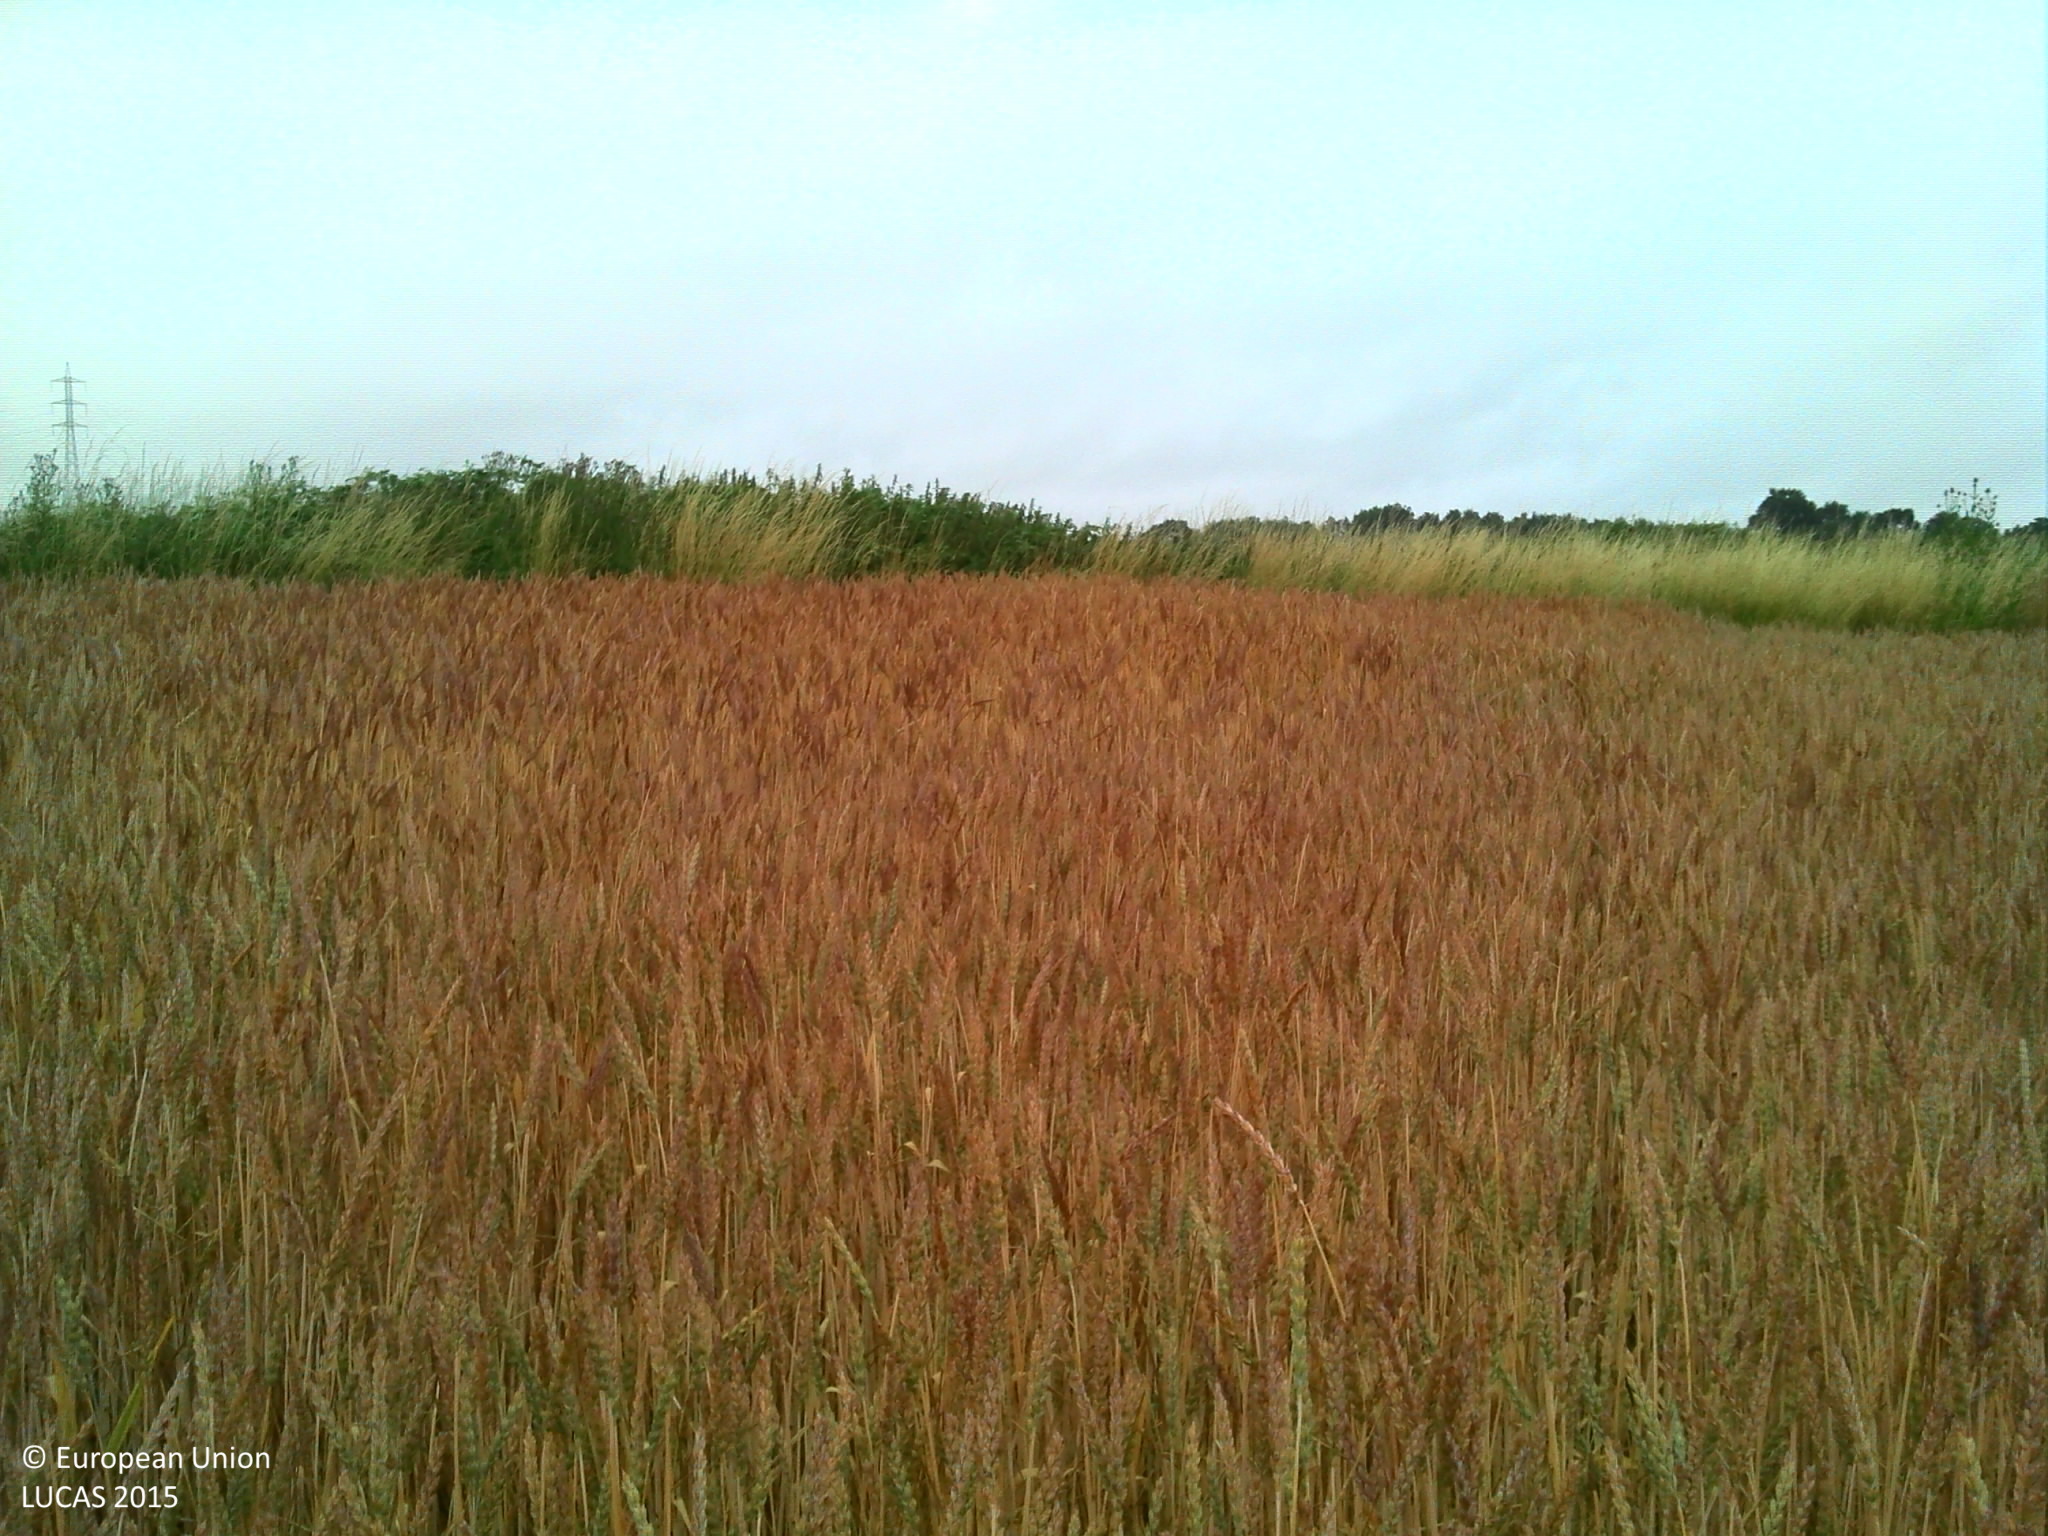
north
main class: Cropland
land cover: Common wheat
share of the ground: > 75 %
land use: Agriculture (excluding fallow land and kitchen gardens)
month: July
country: BE
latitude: 50.2794
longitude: 4.3683
